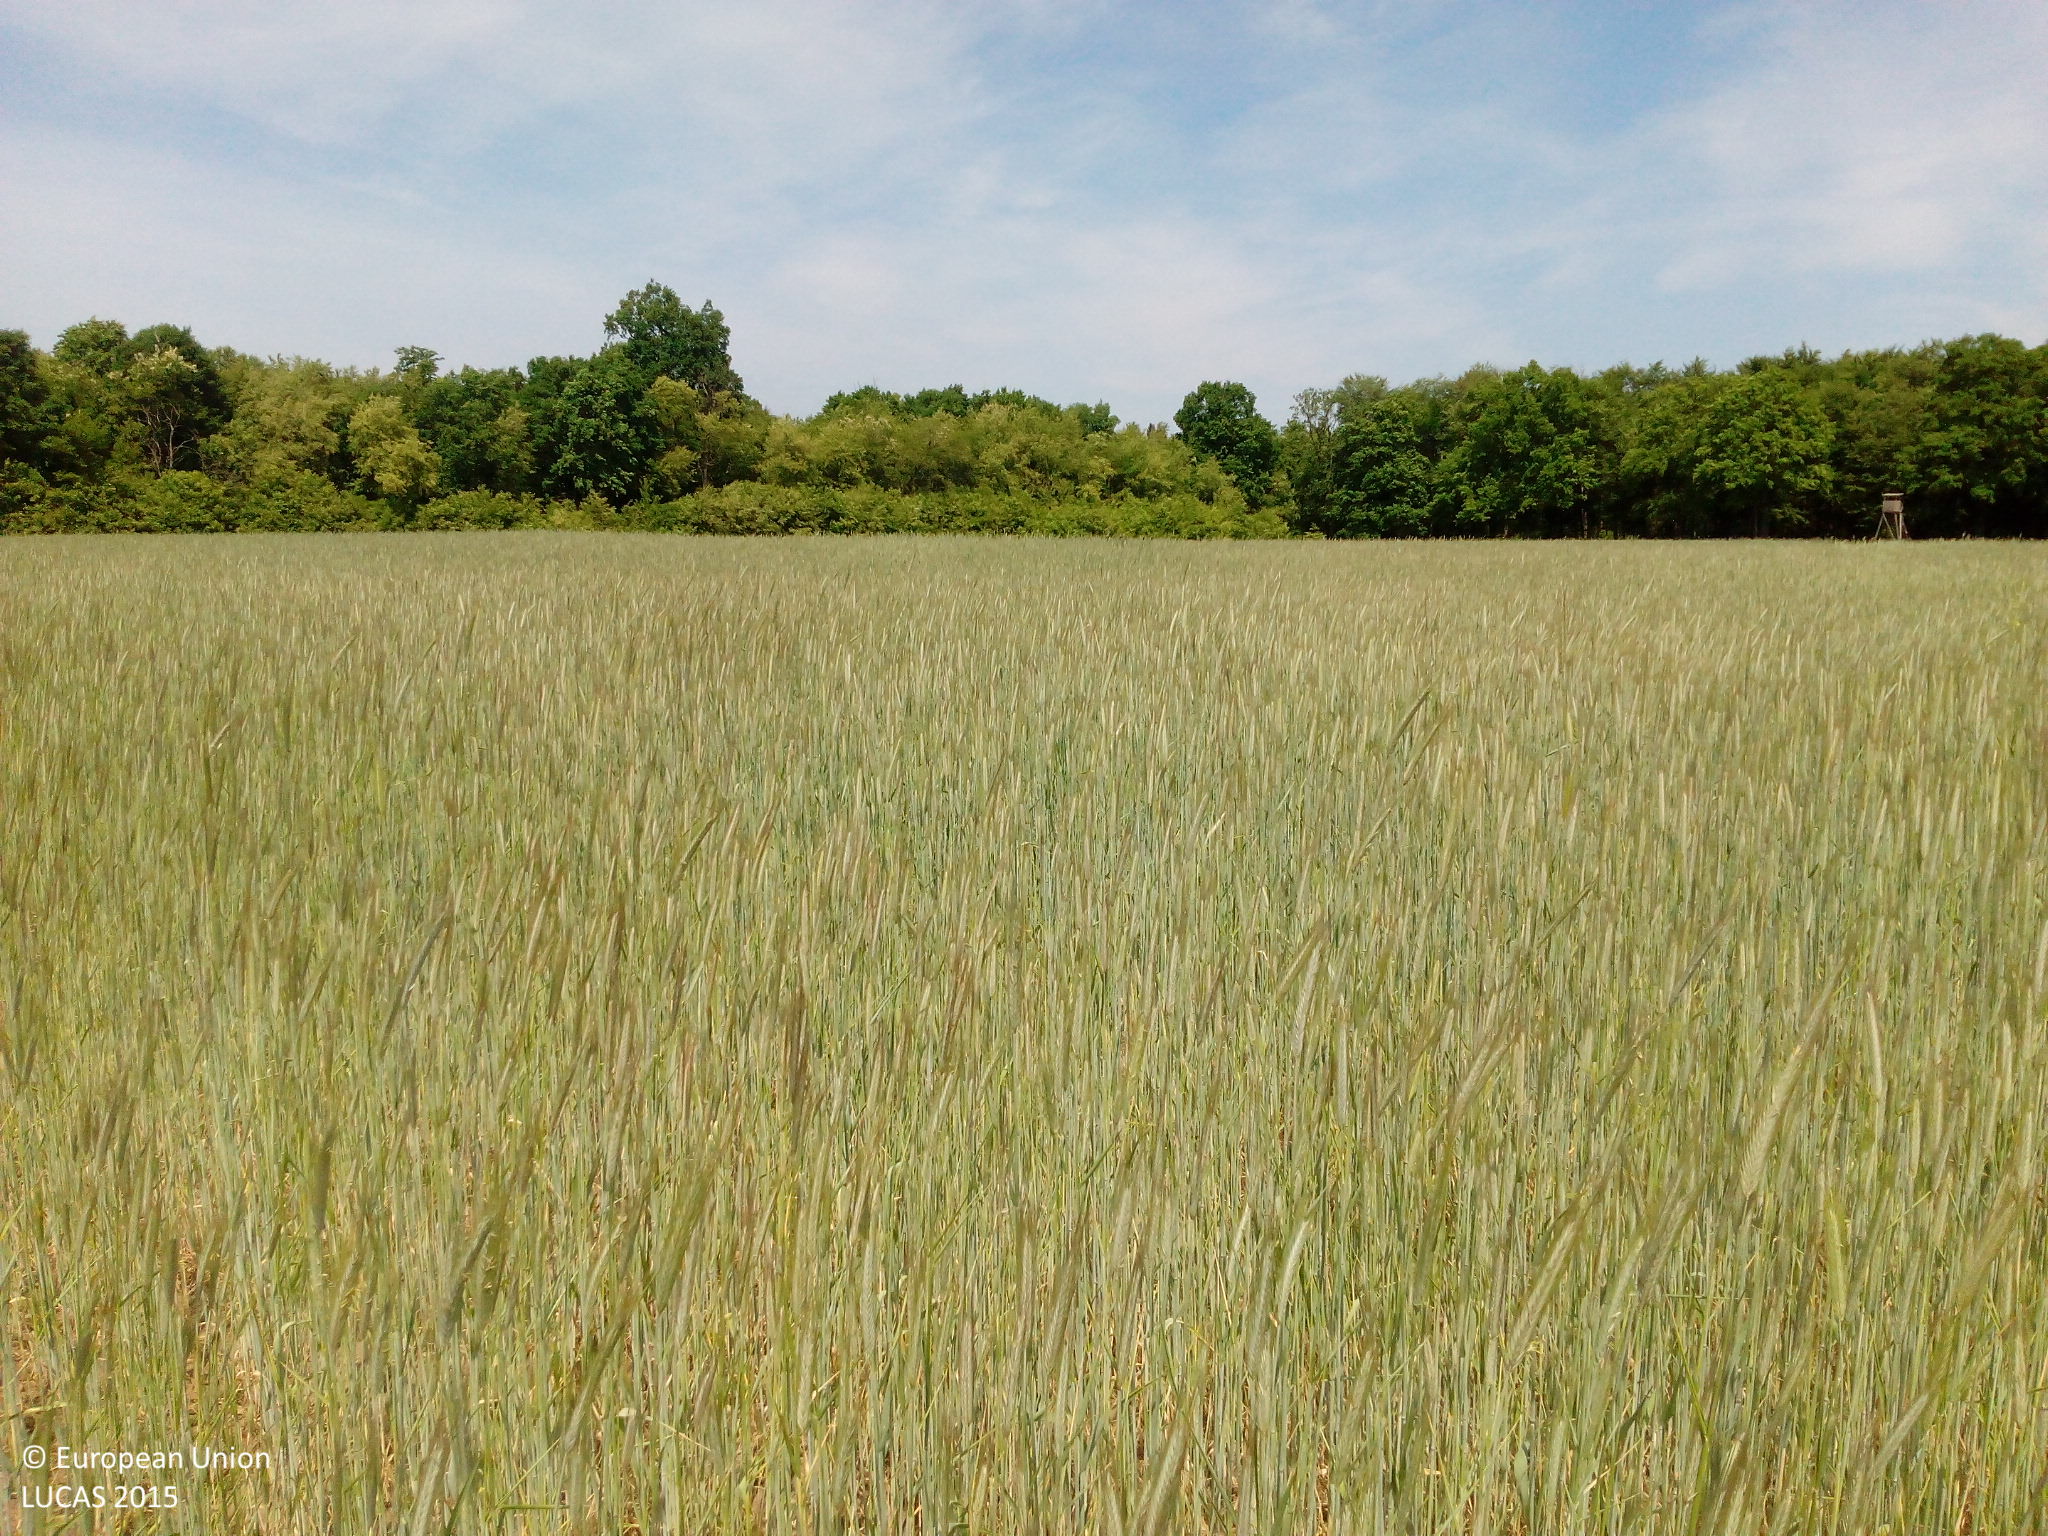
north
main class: Cropland
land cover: Rye
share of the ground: > 75 %
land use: Agriculture (excluding fallow land and kitchen gardens)
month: May
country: DE
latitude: 51.6790
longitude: 14.0360
